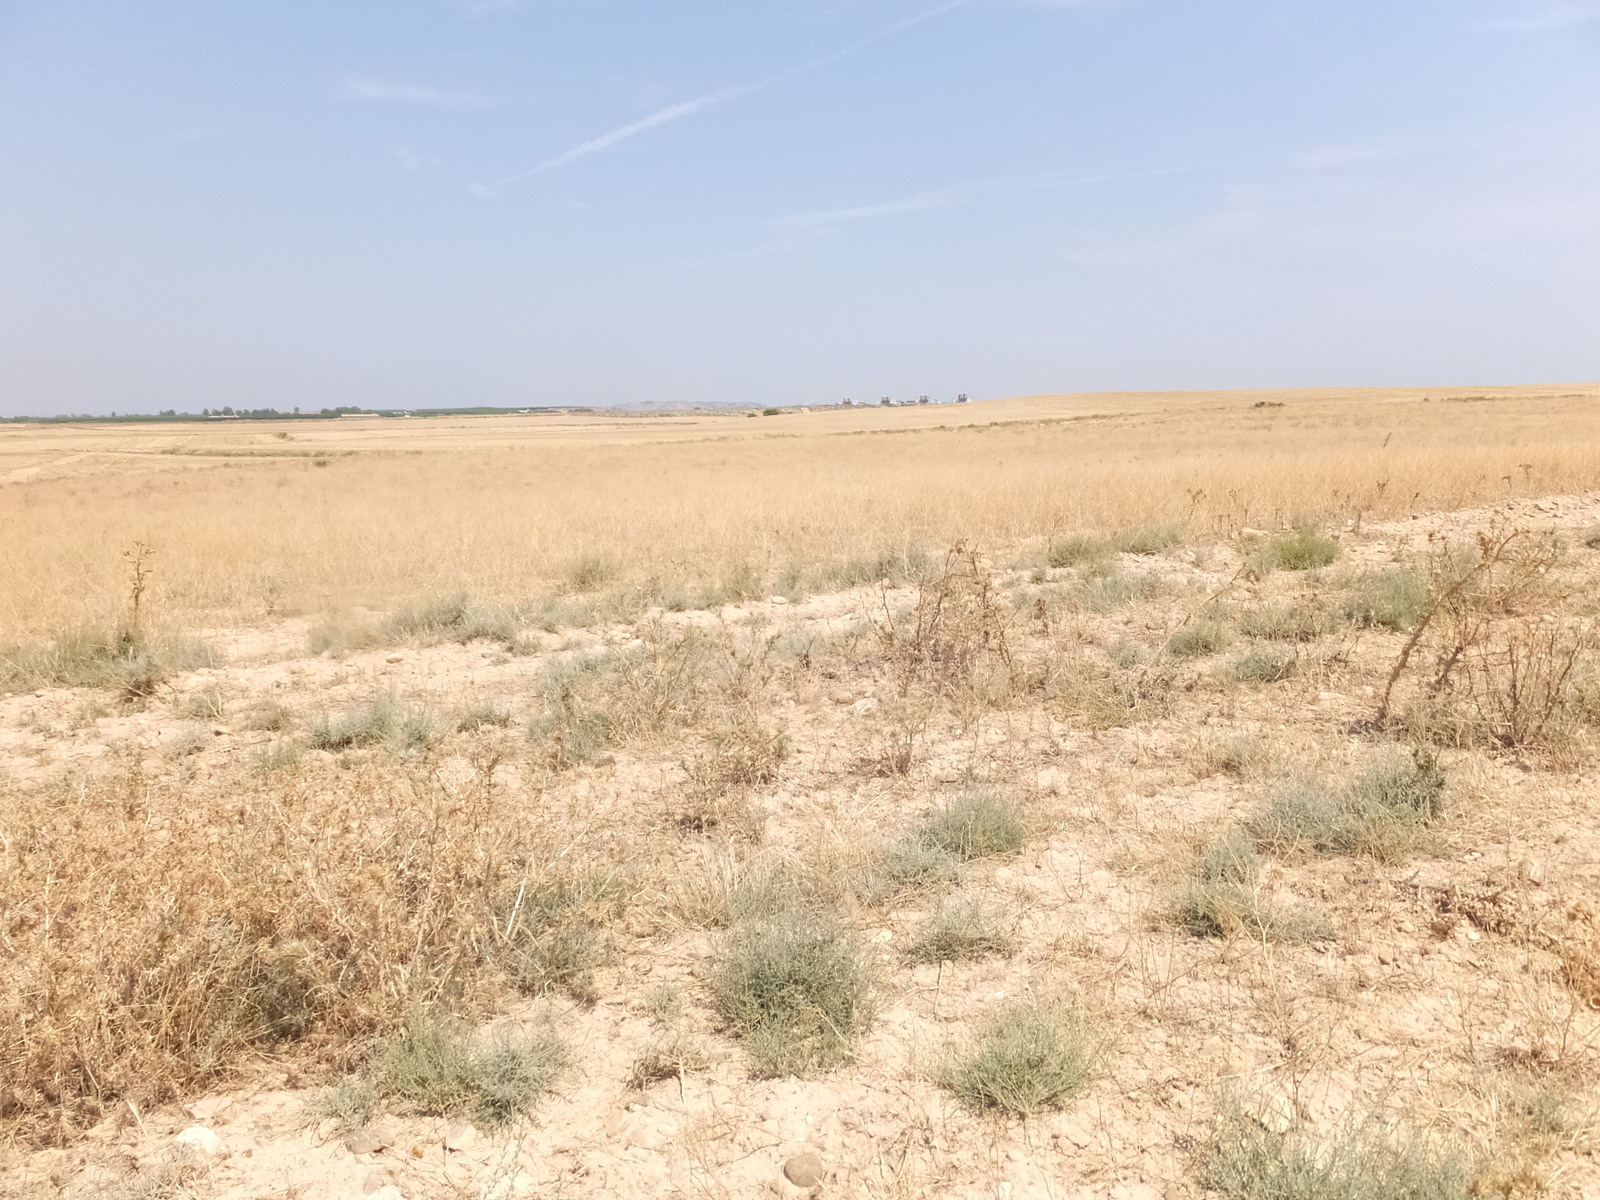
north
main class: Grassland
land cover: Spontaneously vegetated surfaces
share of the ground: > 75 %
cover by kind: herbaceous plants 75 %, unconsolidated bare surface 20 %, shrubs 5 %
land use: Fallow land
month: July
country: ES
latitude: 41.6908
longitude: 0.2412
